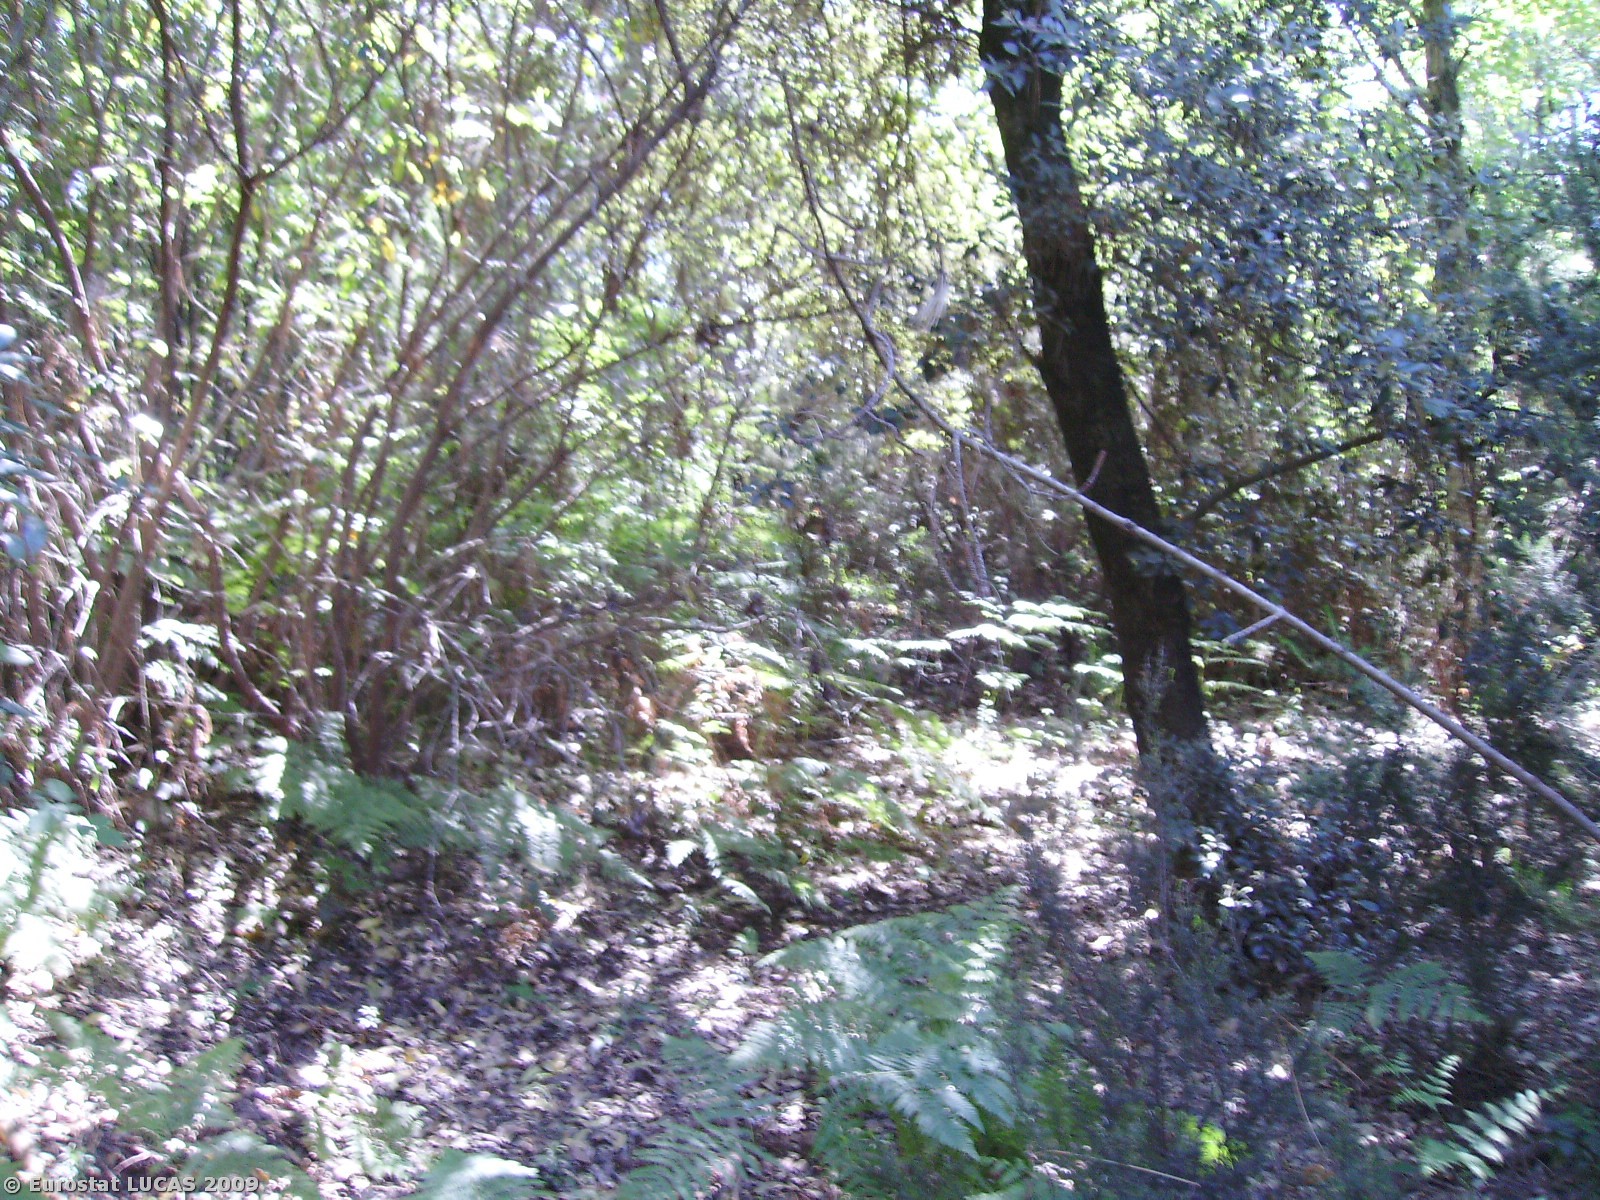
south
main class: Woodland
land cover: Mixed woodland
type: mesophytic deciduous forest
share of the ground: > 75 %
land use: Forestry
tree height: > 5 m
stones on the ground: 25 - 50 %
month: May
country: IT
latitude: 43.0973
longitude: 11.2861
